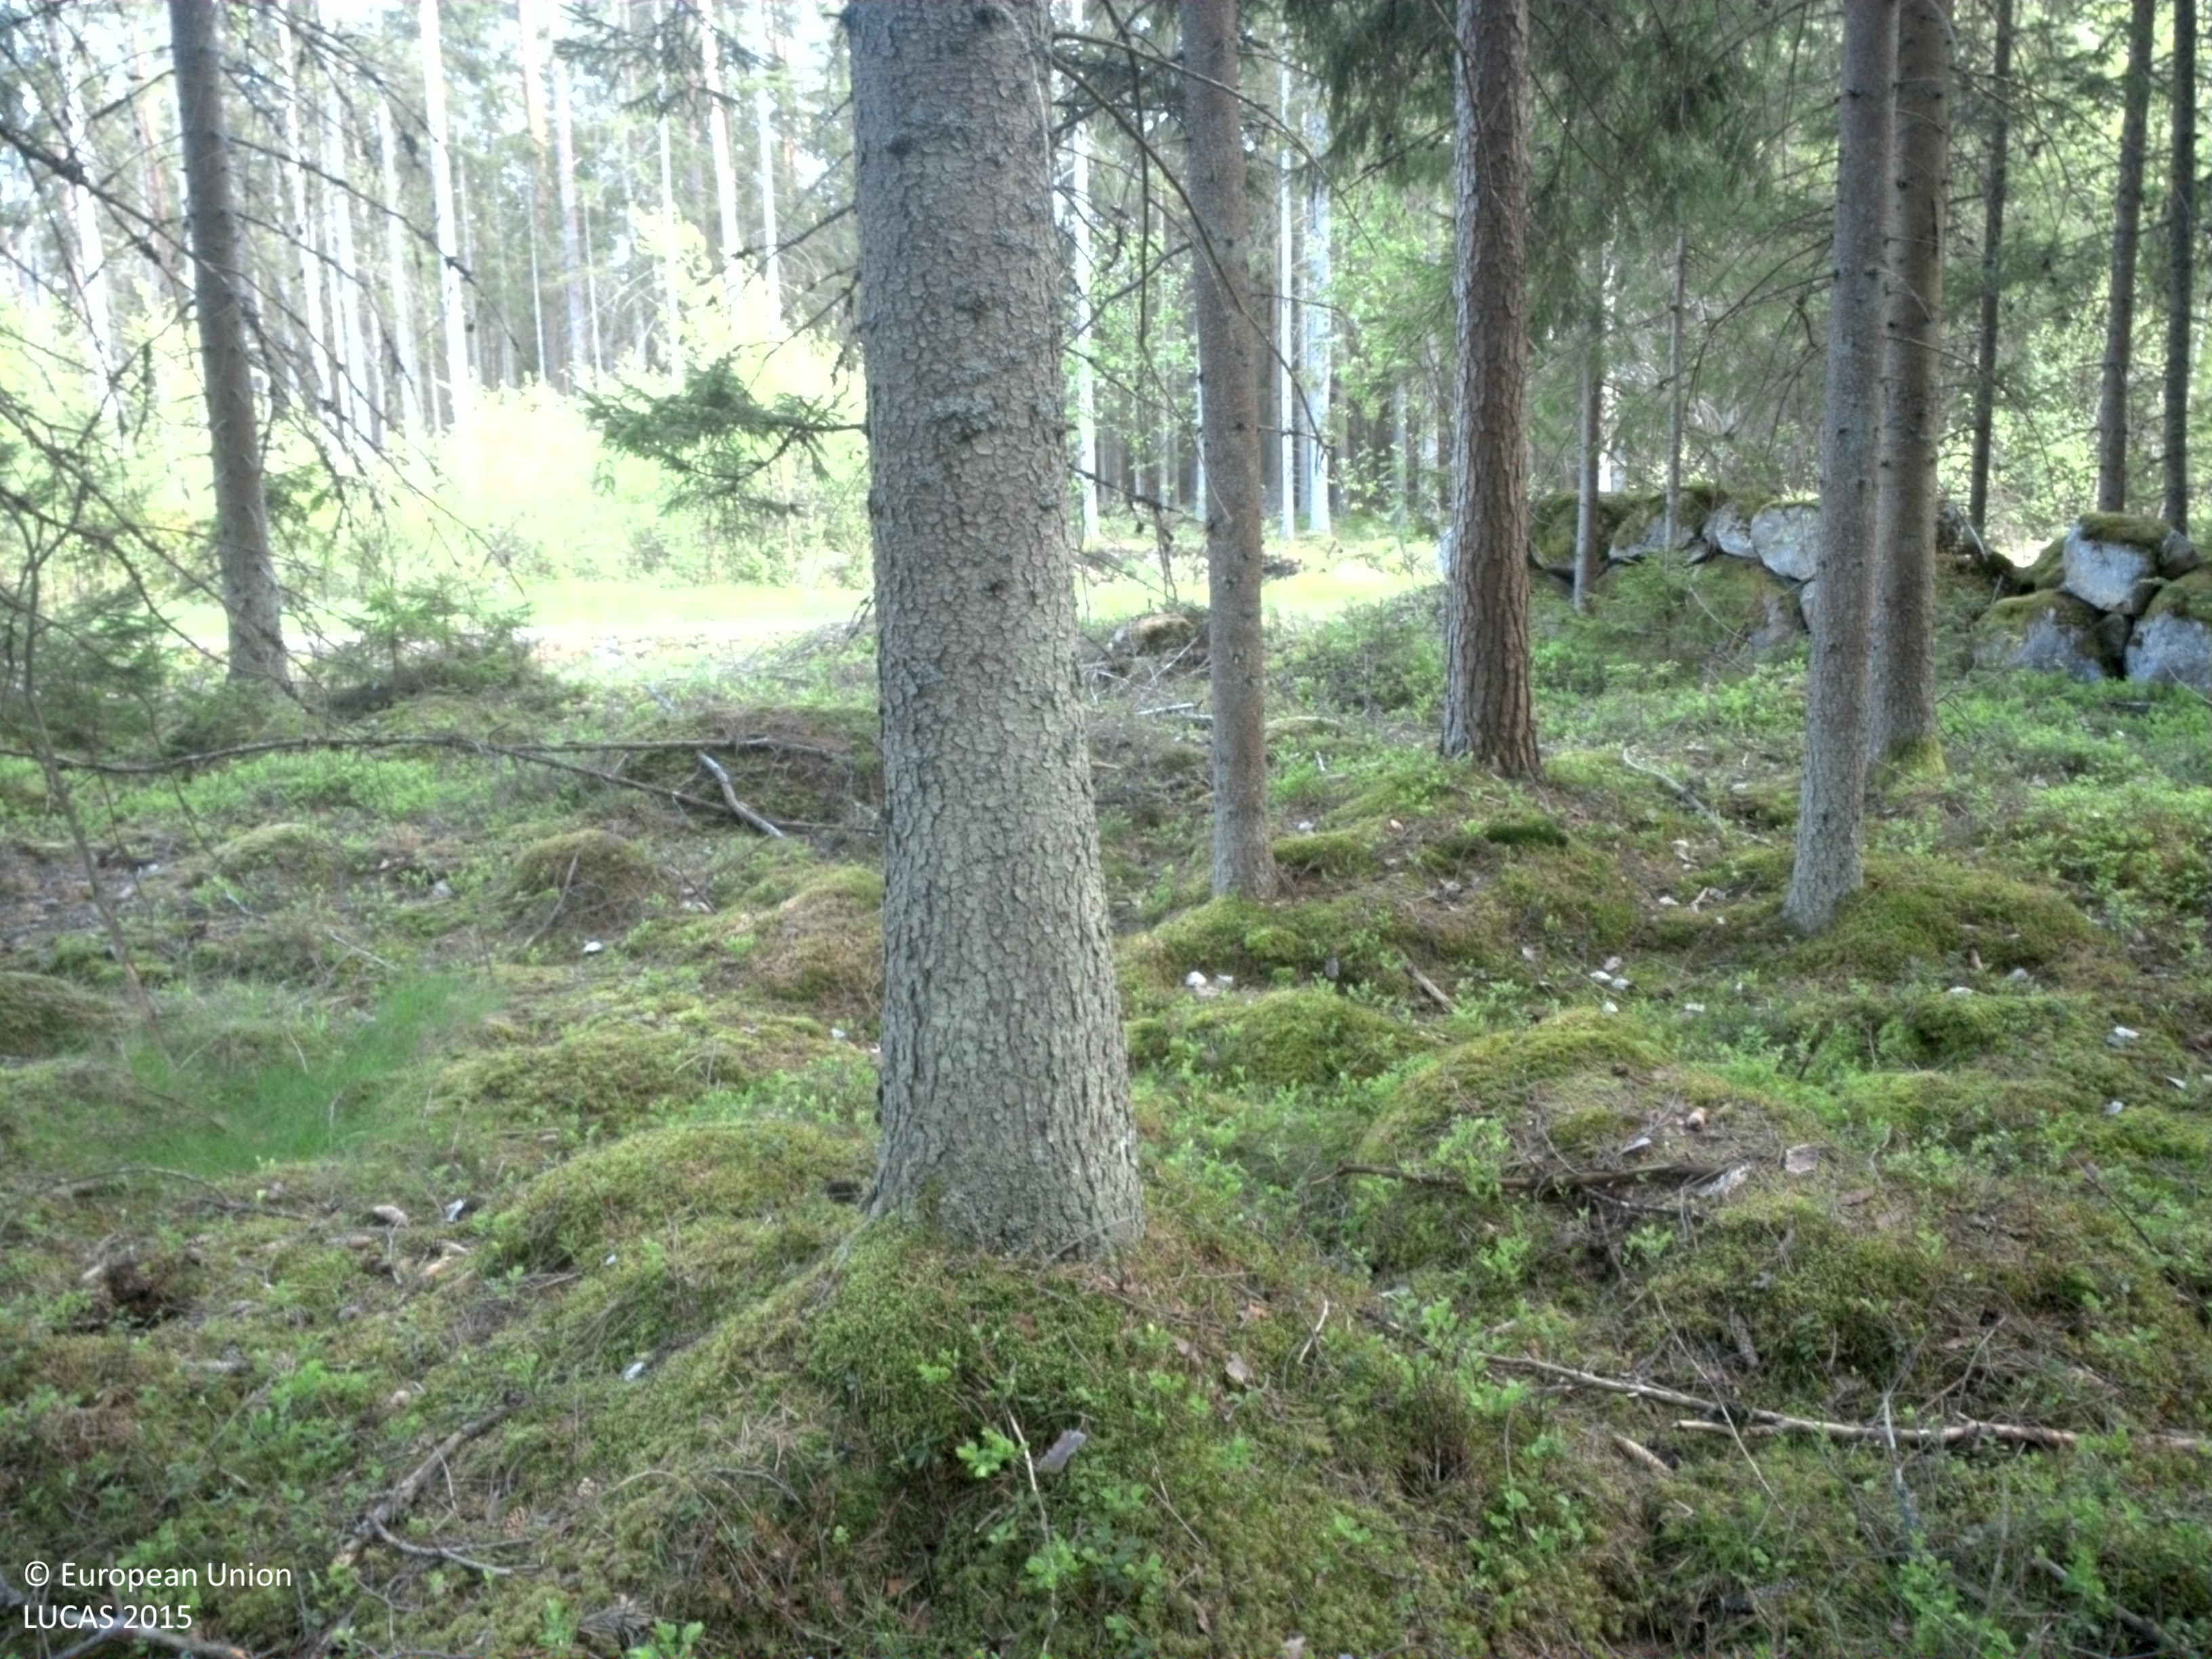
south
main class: Woodland
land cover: Spruce dominated coniferous woodland
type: boreal forest
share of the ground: 50 - 75 %
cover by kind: coniferous forest trees 50 %, shrubs 25 %, lichens and mosses 15 %, herbaceous plants 10 %
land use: Forestry
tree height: > 5 m
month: May
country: SE
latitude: 56.6039
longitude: 15.2273
